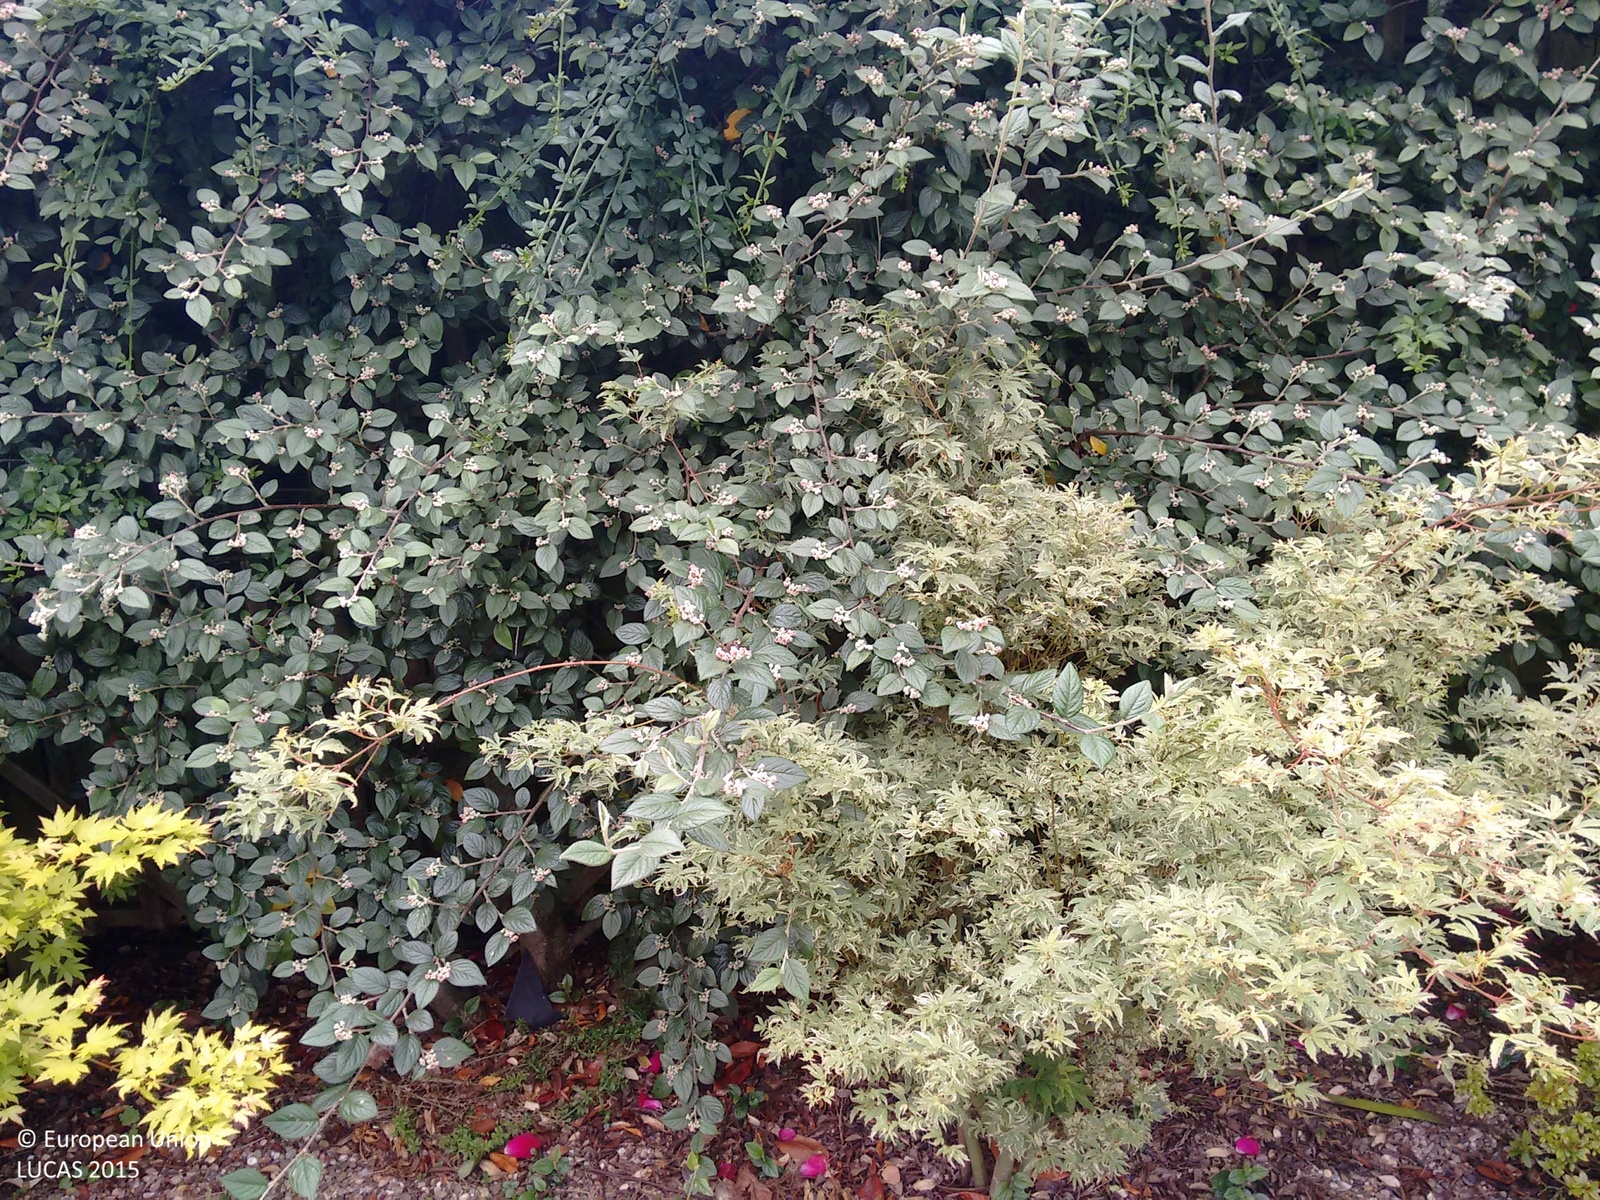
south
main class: Grassland
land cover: Grassland with sparse tree/shrub cover
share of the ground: > 75 %
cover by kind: herbaceous plants 90 %, broadleaved forest trees 5 %, shrubs 5 %
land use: Residential
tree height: < 5 m
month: June
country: GB
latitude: 52.2394
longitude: -2.1718
